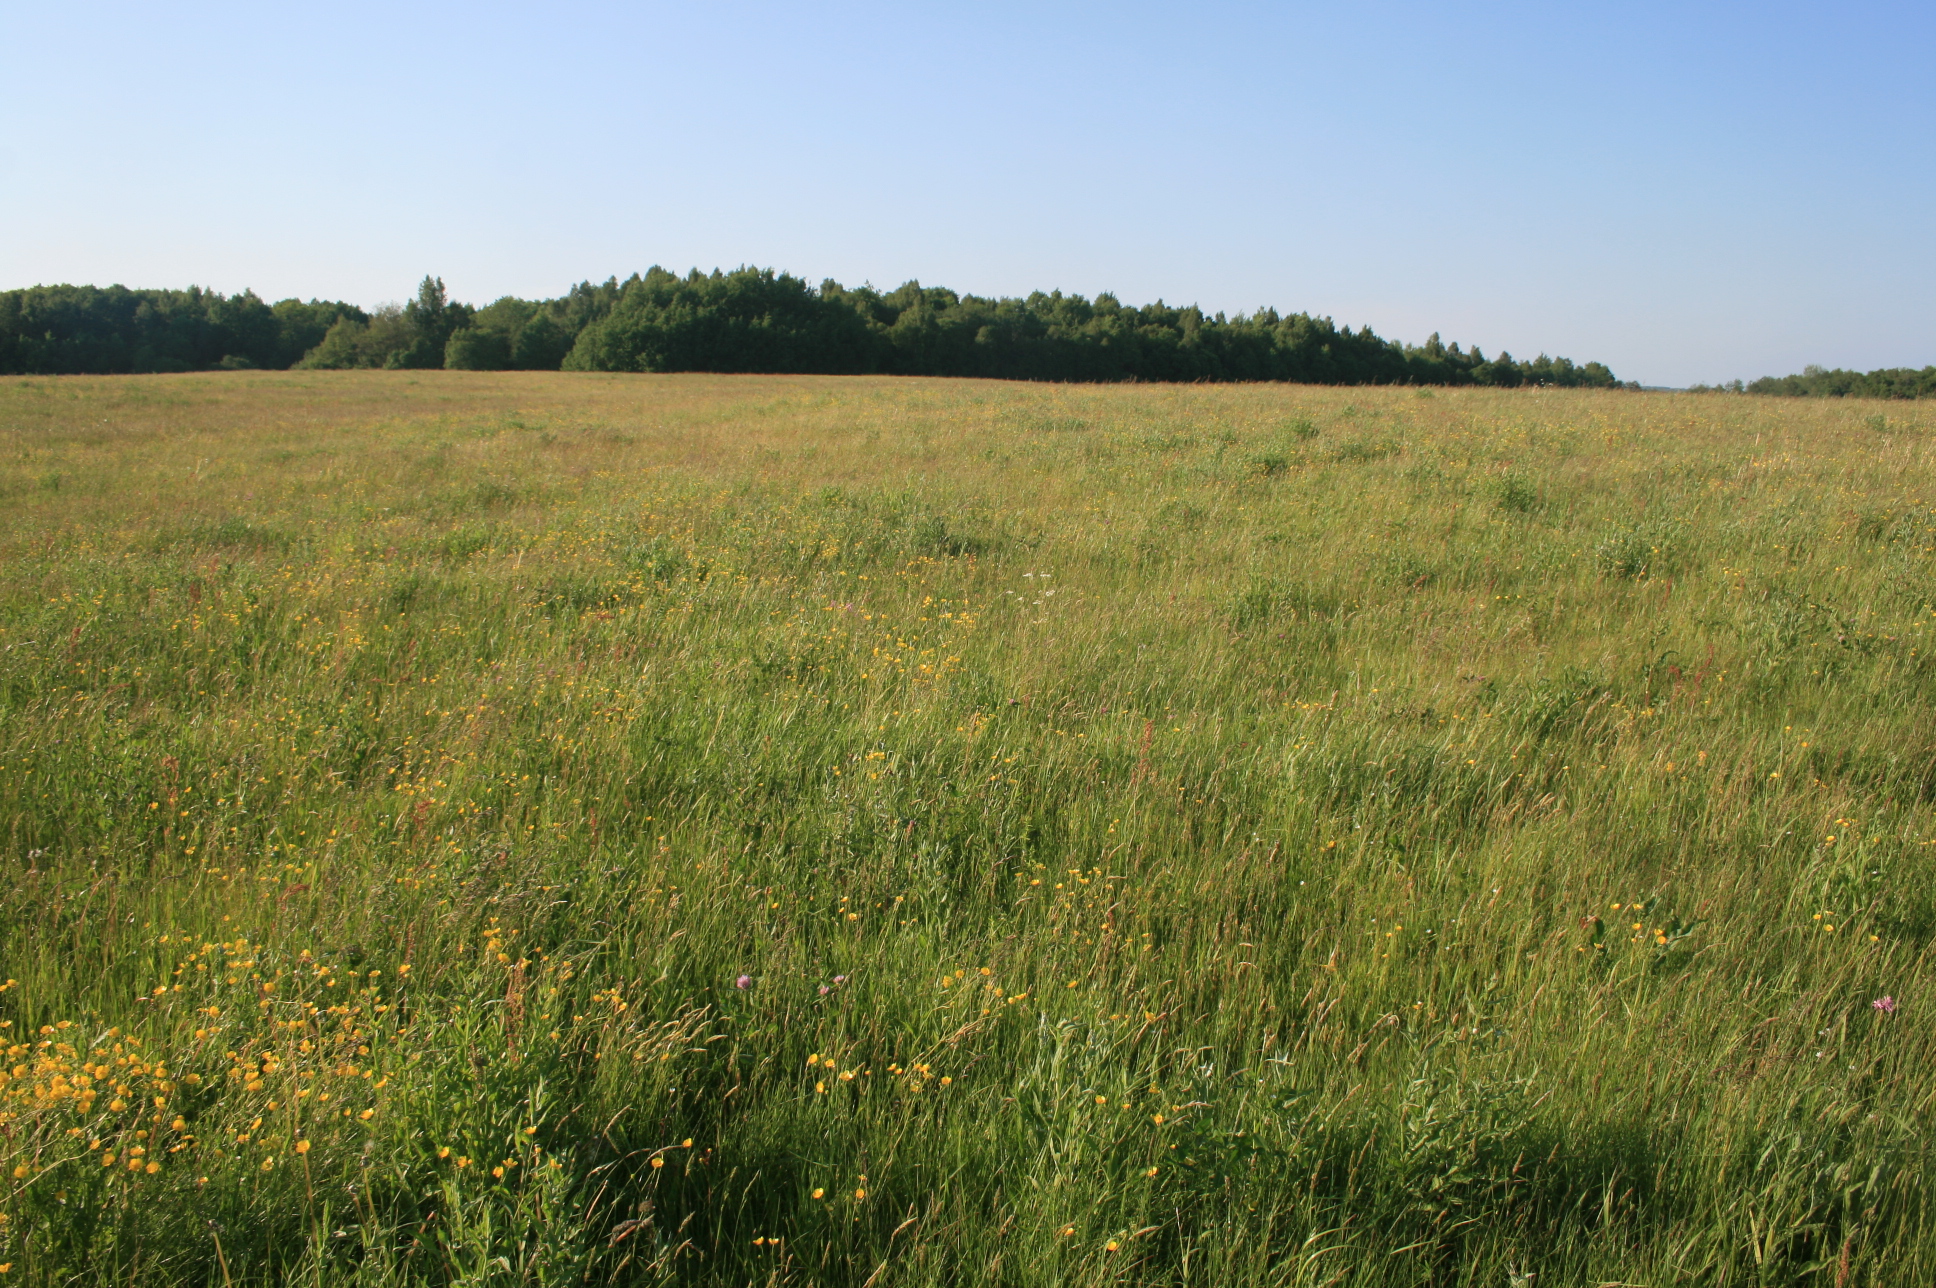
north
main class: Grassland
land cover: Grassland without tree/shrub cover
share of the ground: > 75 %
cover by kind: herbaceous plants 100 %
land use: Agriculture (excluding fallow land and kitchen gardens)
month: June
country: LT
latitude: 55.6739
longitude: 22.2201
